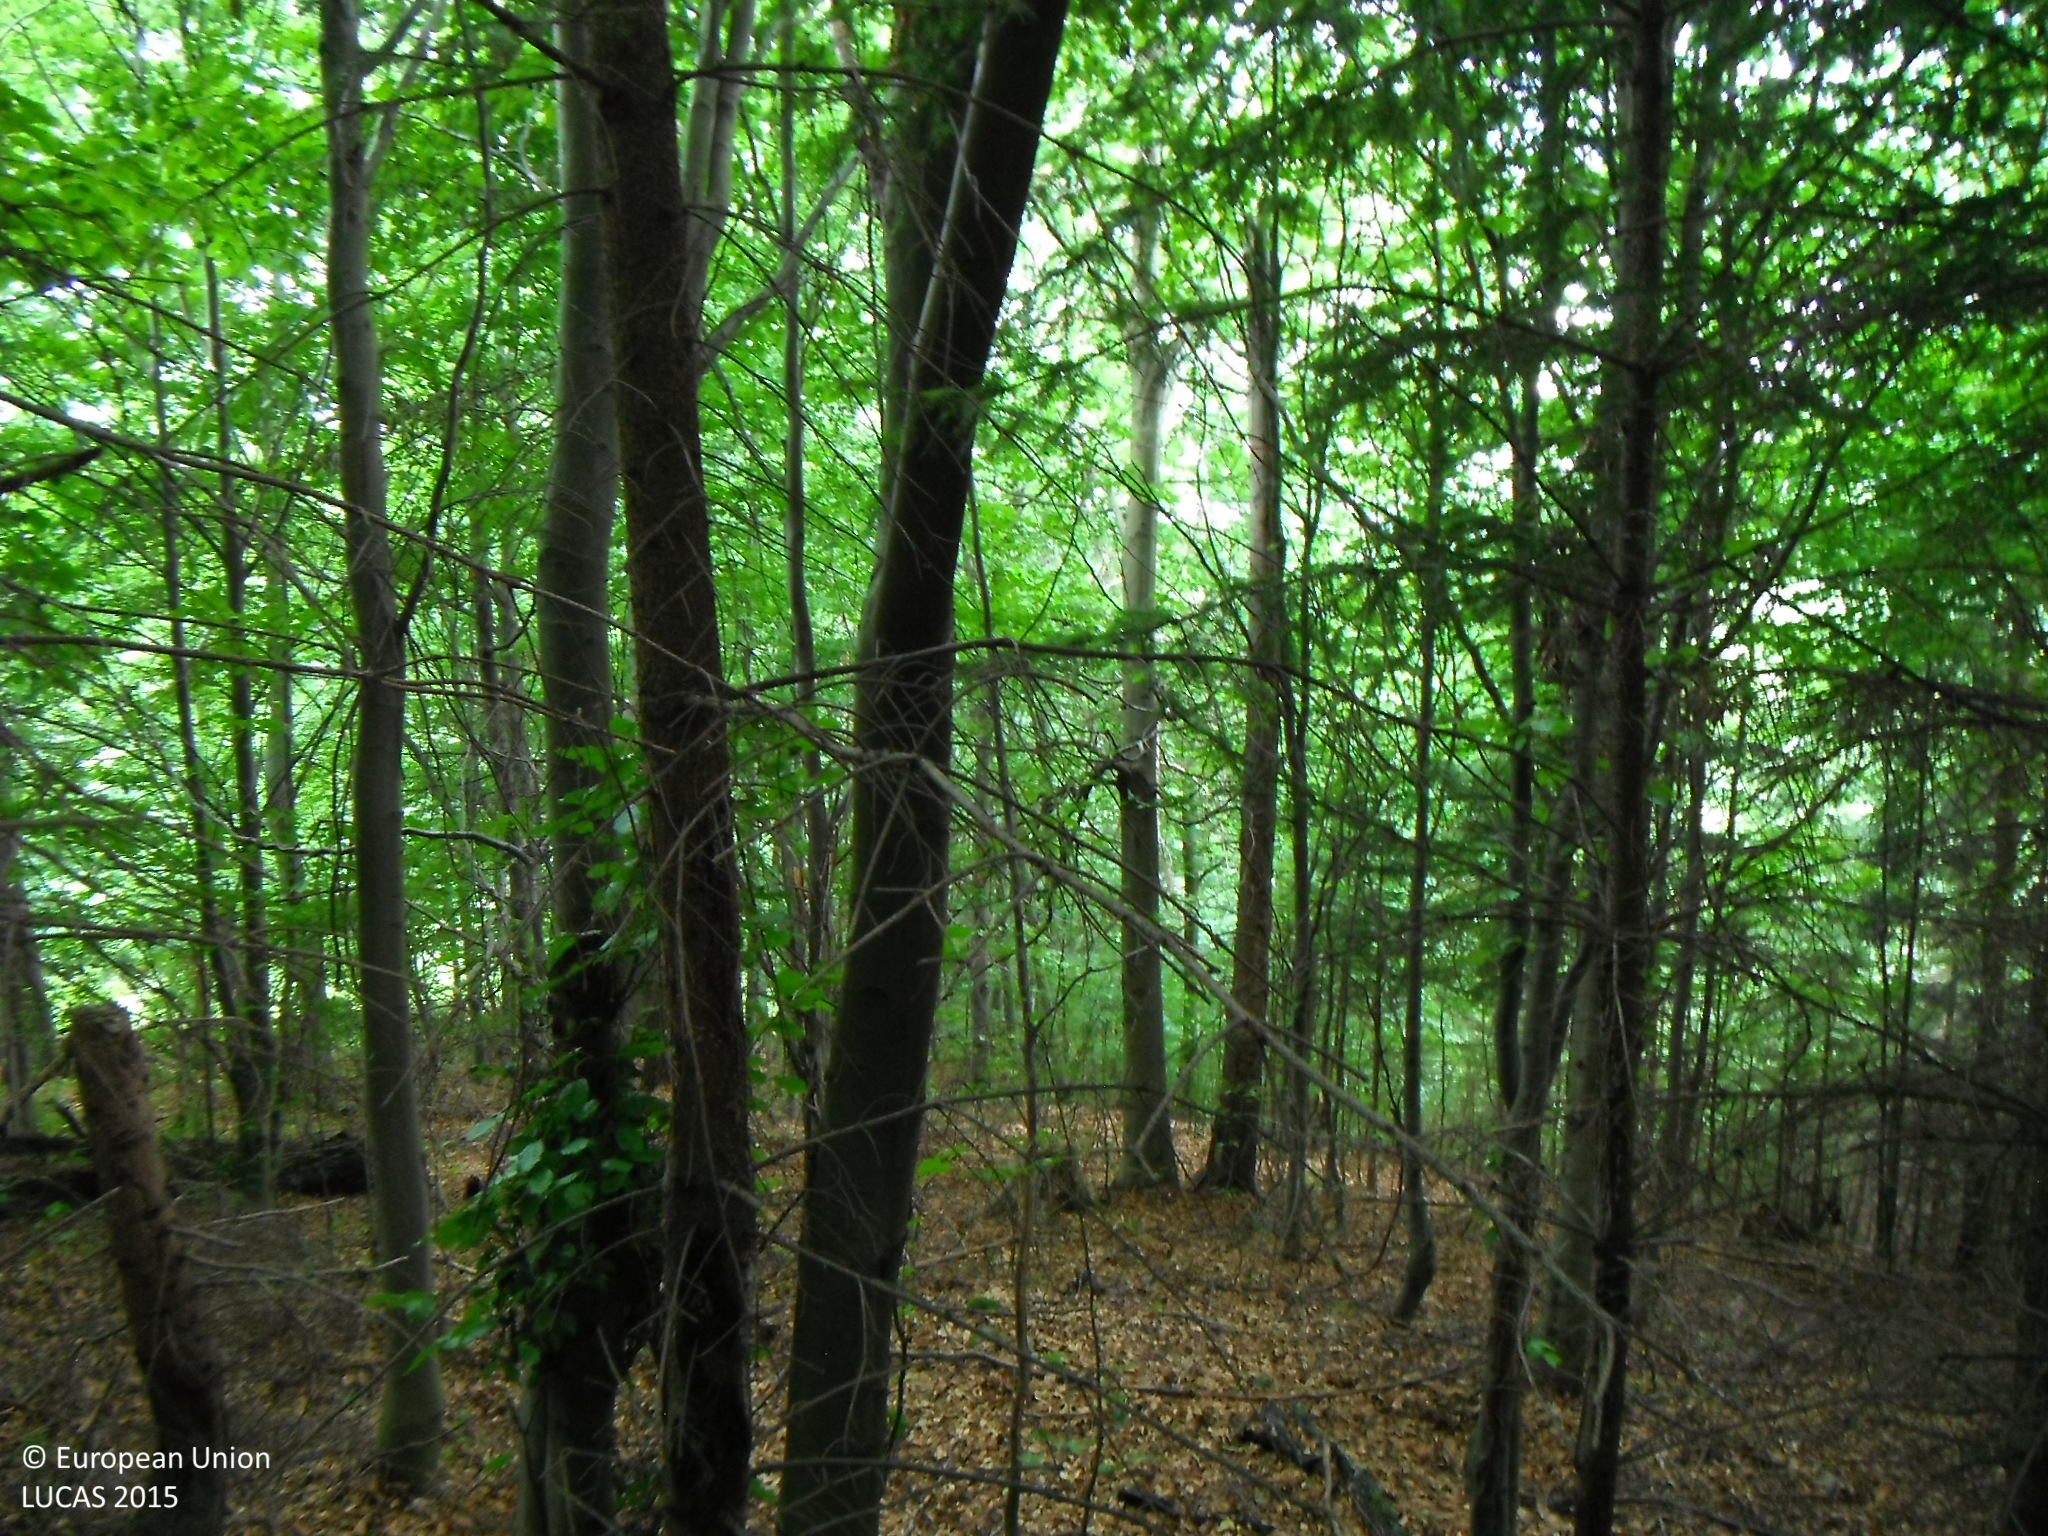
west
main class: Woodland
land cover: Spruce dominated coniferous woodland
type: alpine coniferous forest
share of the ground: > 75 %
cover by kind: coniferous forest trees 80 %, broadleaved forest trees 20 %
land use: Forestry
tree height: > 5 m
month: July
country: SK
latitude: 49.2570
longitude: 20.9374
